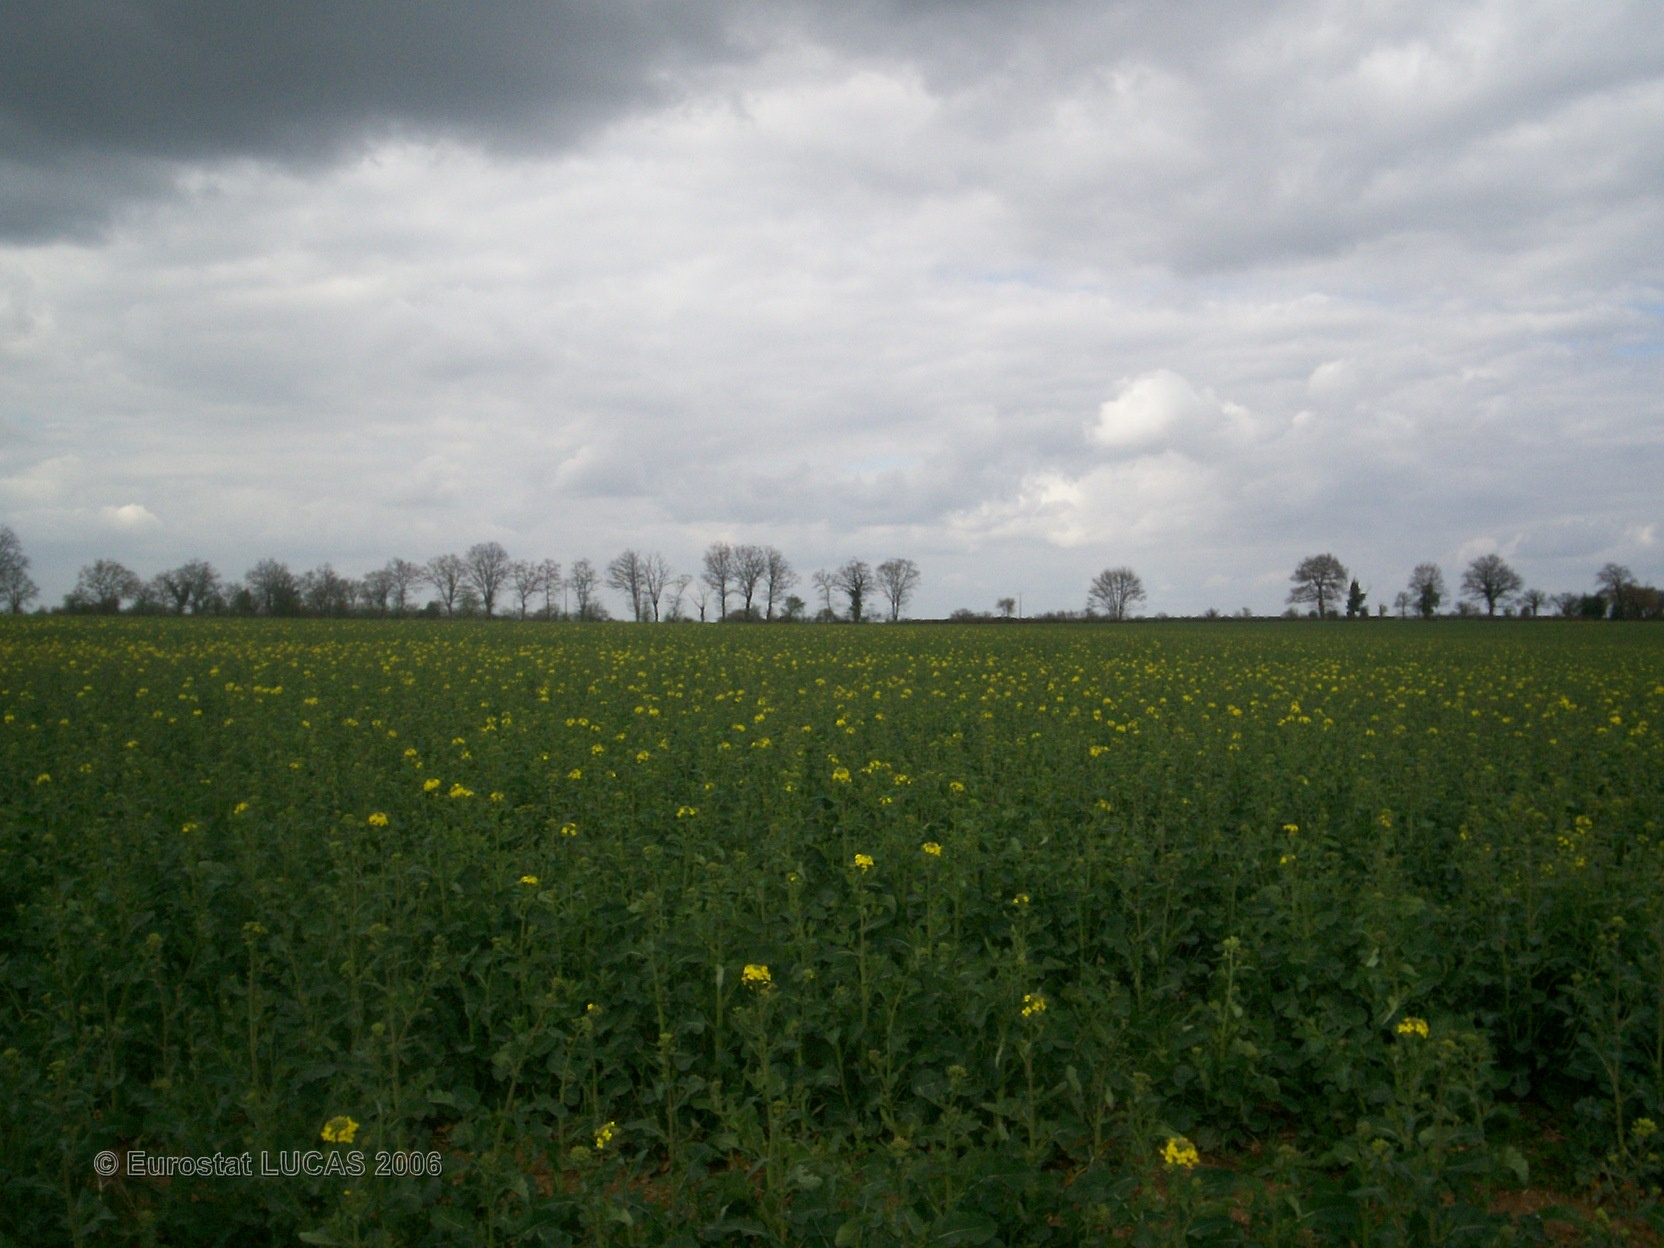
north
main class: Cropland
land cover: Rape and turnip rape
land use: Agriculture (excluding fallow land and kitchen gardens)
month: April
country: FR
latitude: 46.4124
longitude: 1.0758
